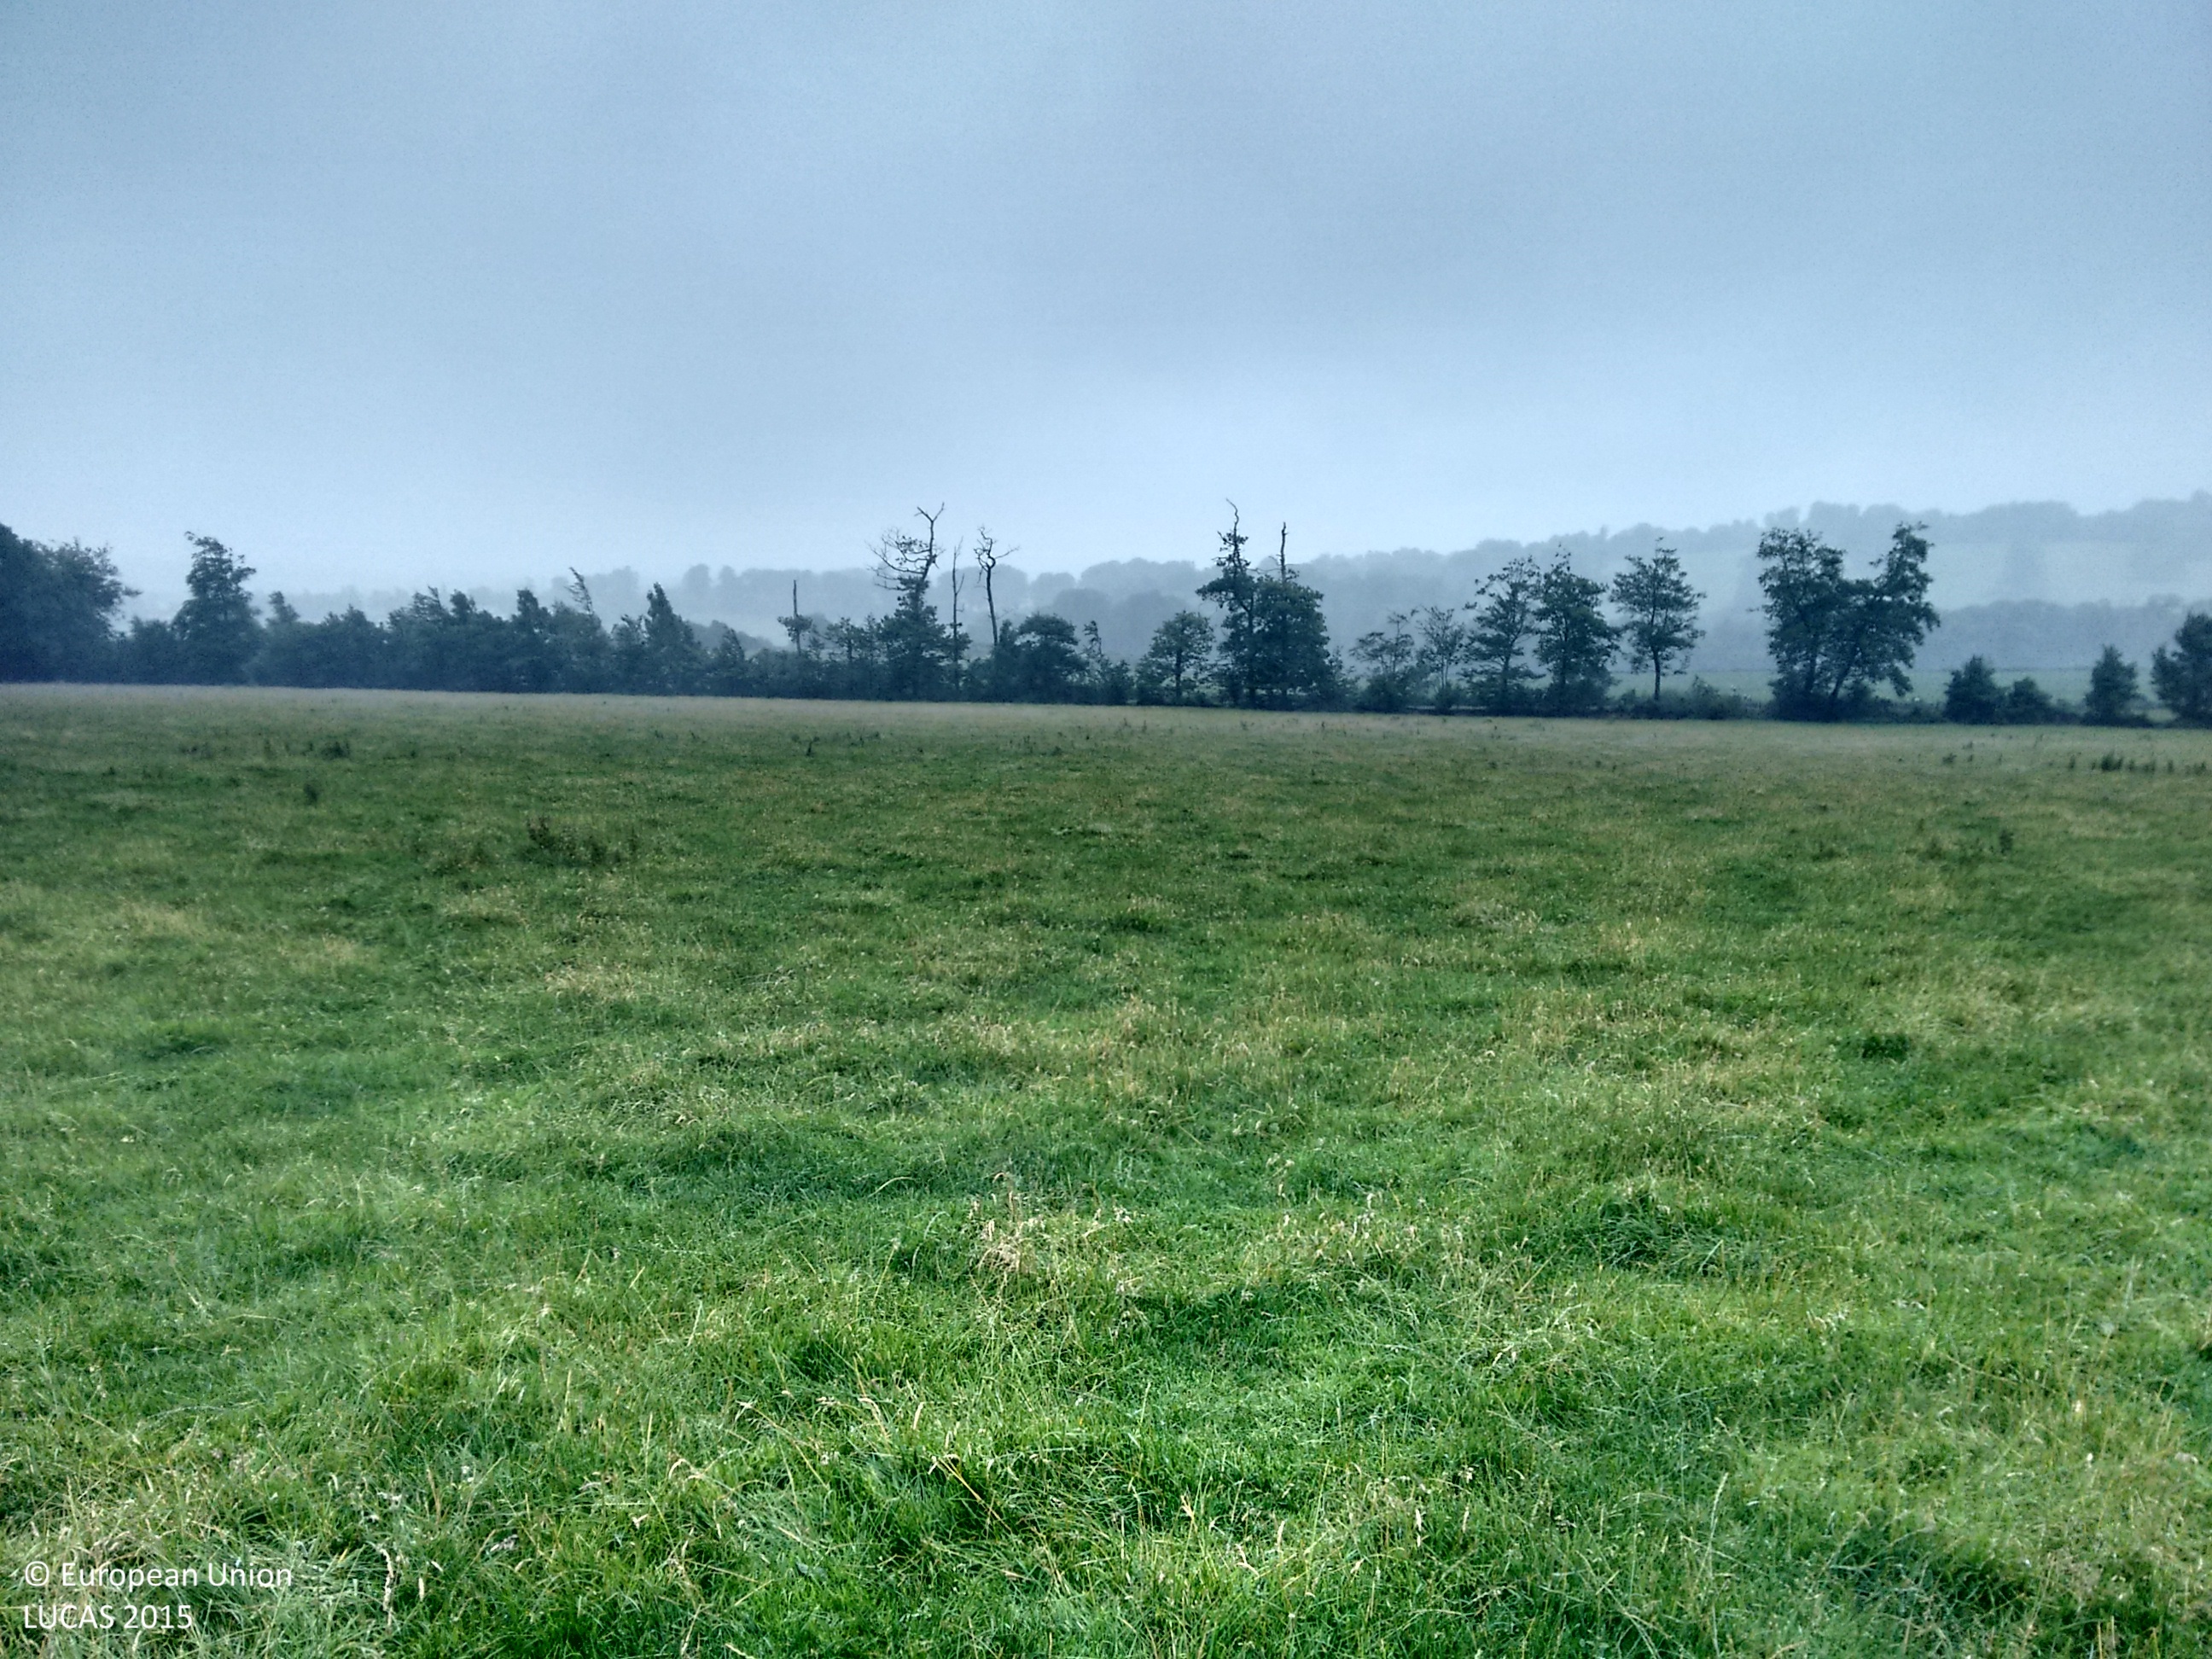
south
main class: Grassland
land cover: Grassland without tree/shrub cover
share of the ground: > 75 %
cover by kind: herbaceous plants 100 %
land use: Agriculture (excluding fallow land and kitchen gardens)
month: August
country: IE
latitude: 52.7480
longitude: -6.2838
